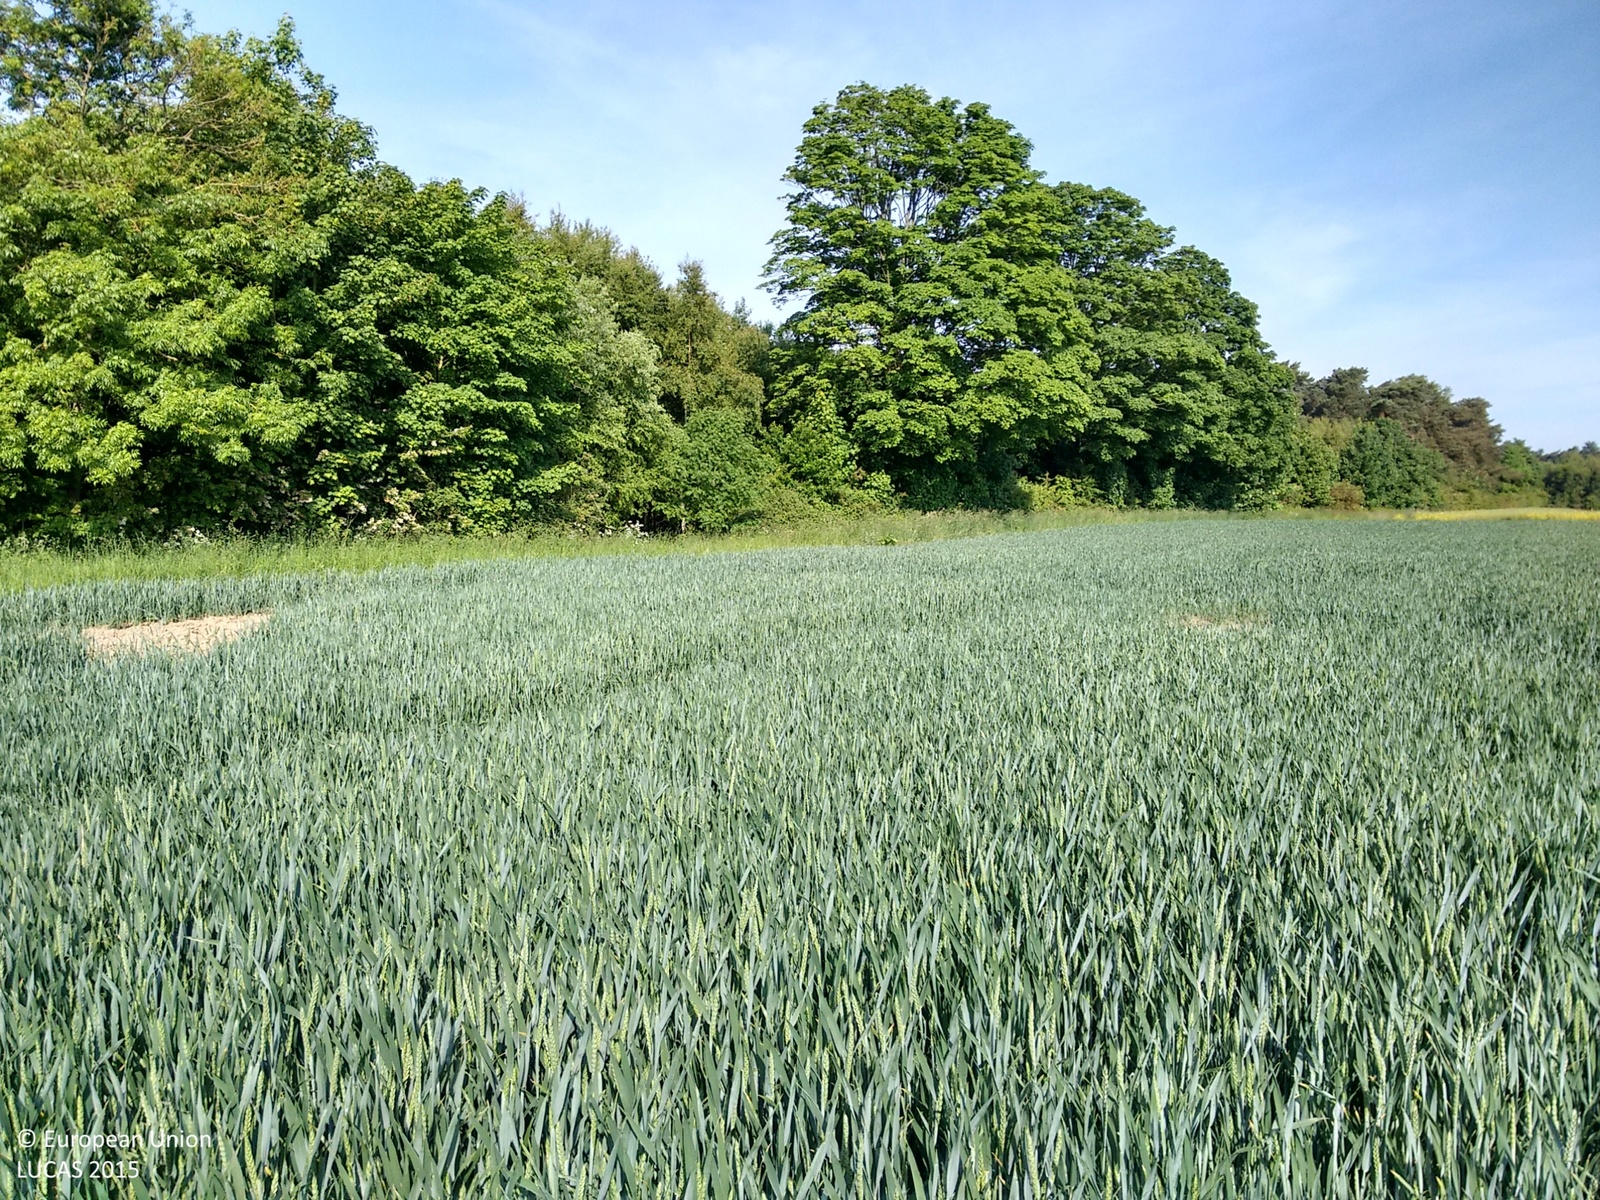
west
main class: Cropland
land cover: Common wheat
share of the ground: > 75 %
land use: Agriculture (excluding fallow land and kitchen gardens)
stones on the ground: < 10 %
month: June
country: GB
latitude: 53.7938
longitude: -1.1419
